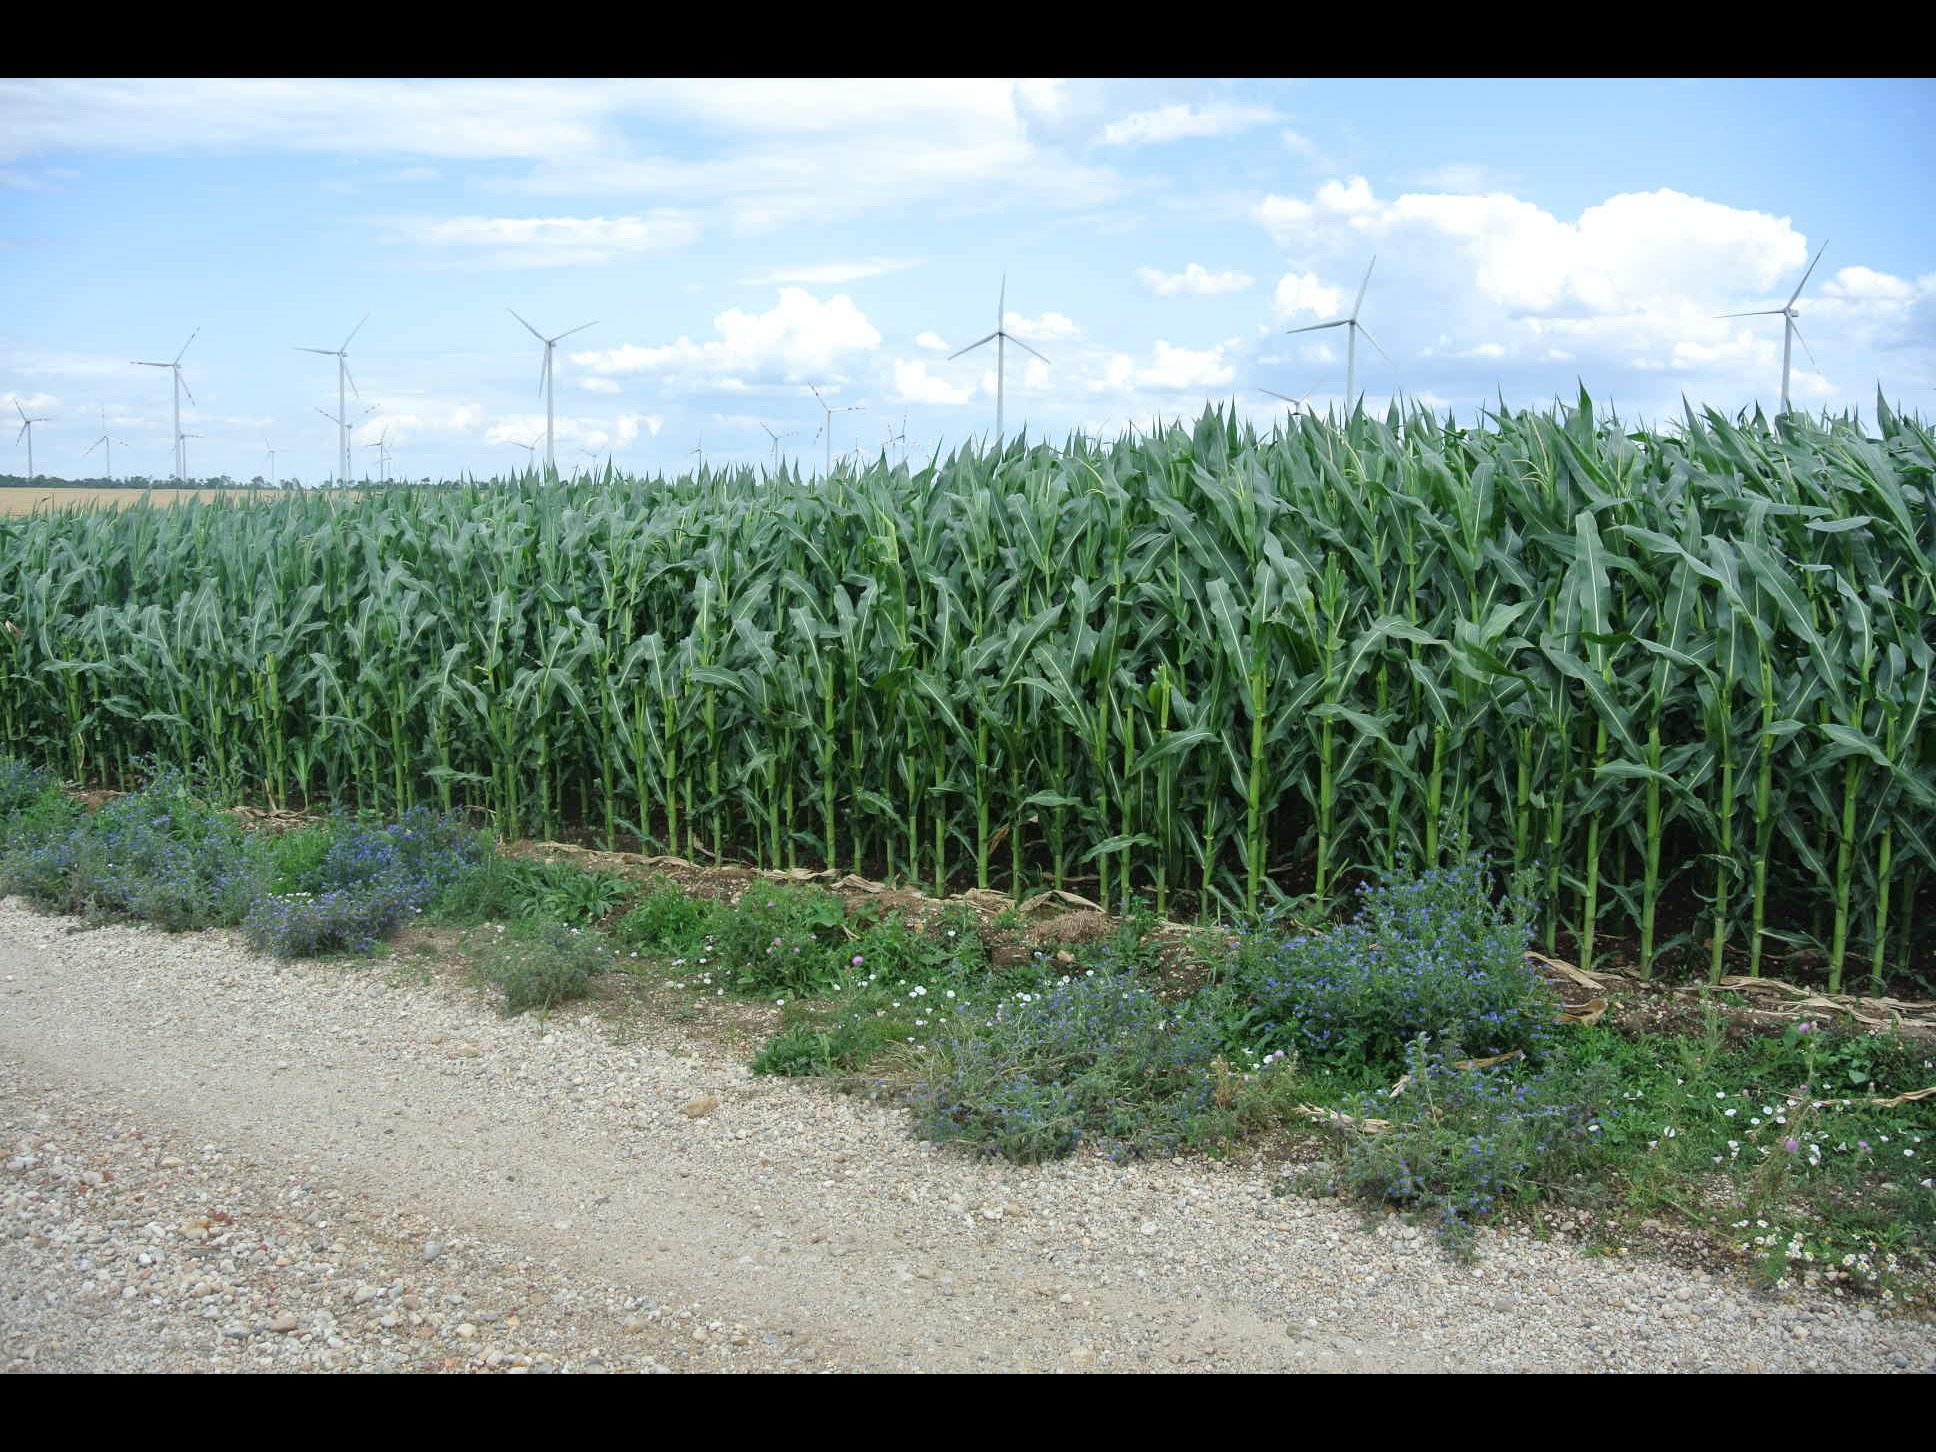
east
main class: Cropland
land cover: Common wheat
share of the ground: > 75 %
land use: Agriculture (excluding fallow land and kitchen gardens)
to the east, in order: Common wheat; Grass margins; Tracks; Grass margins; Maize; Common wheat
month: July
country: AT
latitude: 47.9333
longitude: 16.9268
